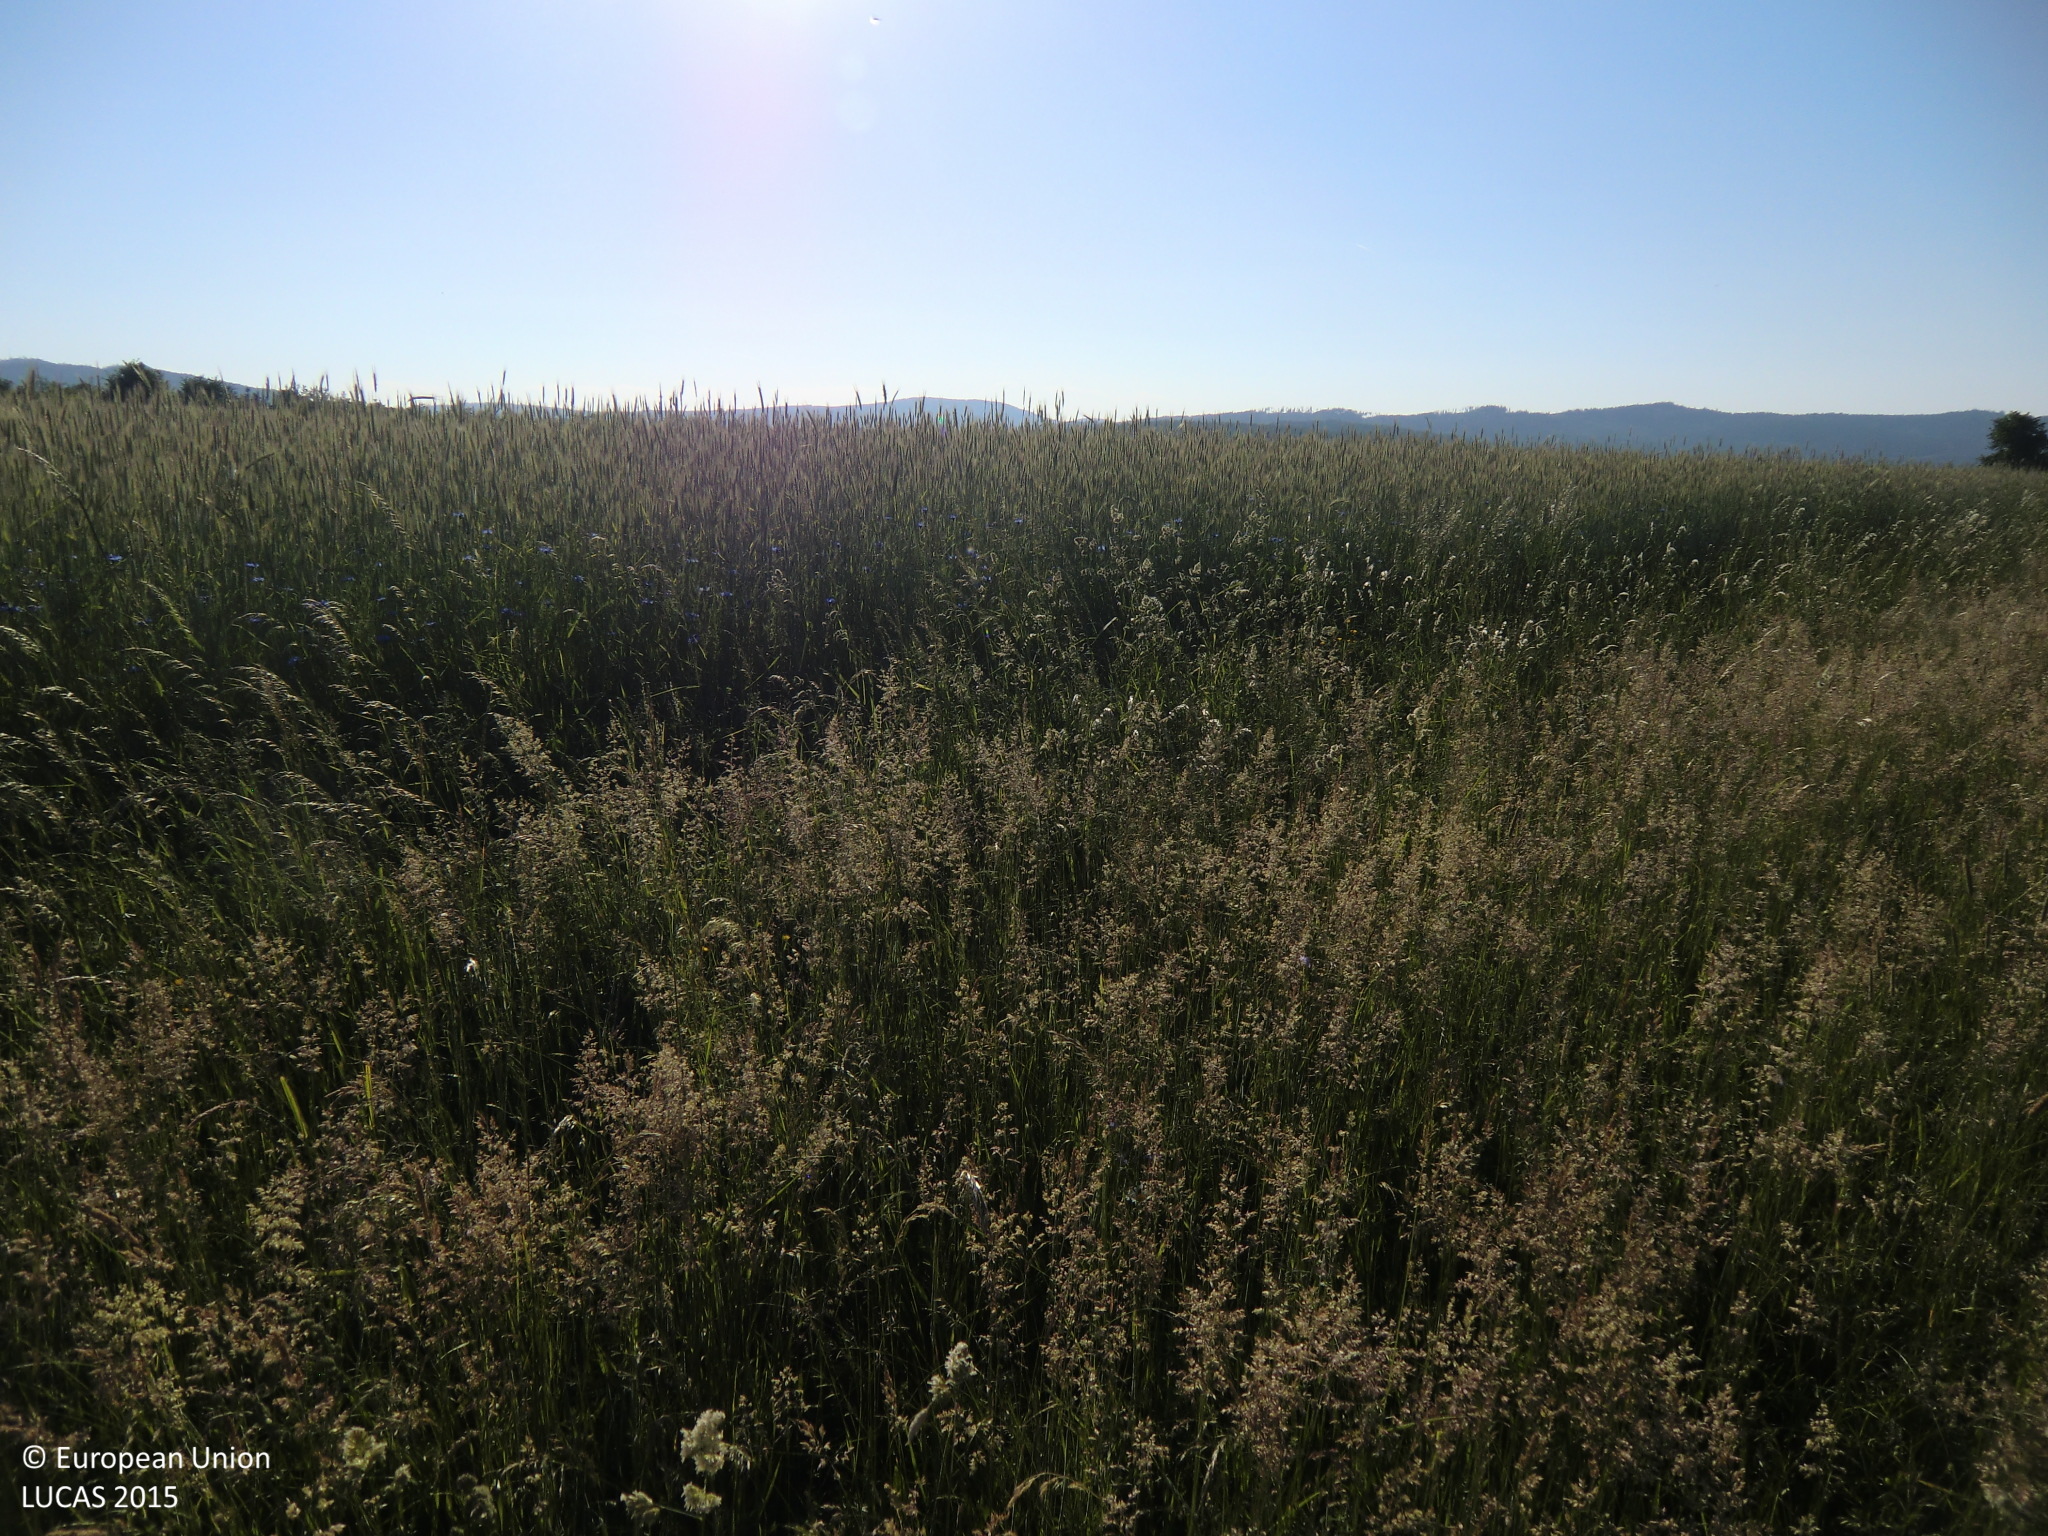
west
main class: Grassland
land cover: Grassland without tree/shrub cover
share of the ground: > 75 %
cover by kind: herbaceous plants 100 %
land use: Agriculture (excluding fallow land and kitchen gardens)
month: June
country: AT
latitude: 48.6924
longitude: 14.8787
